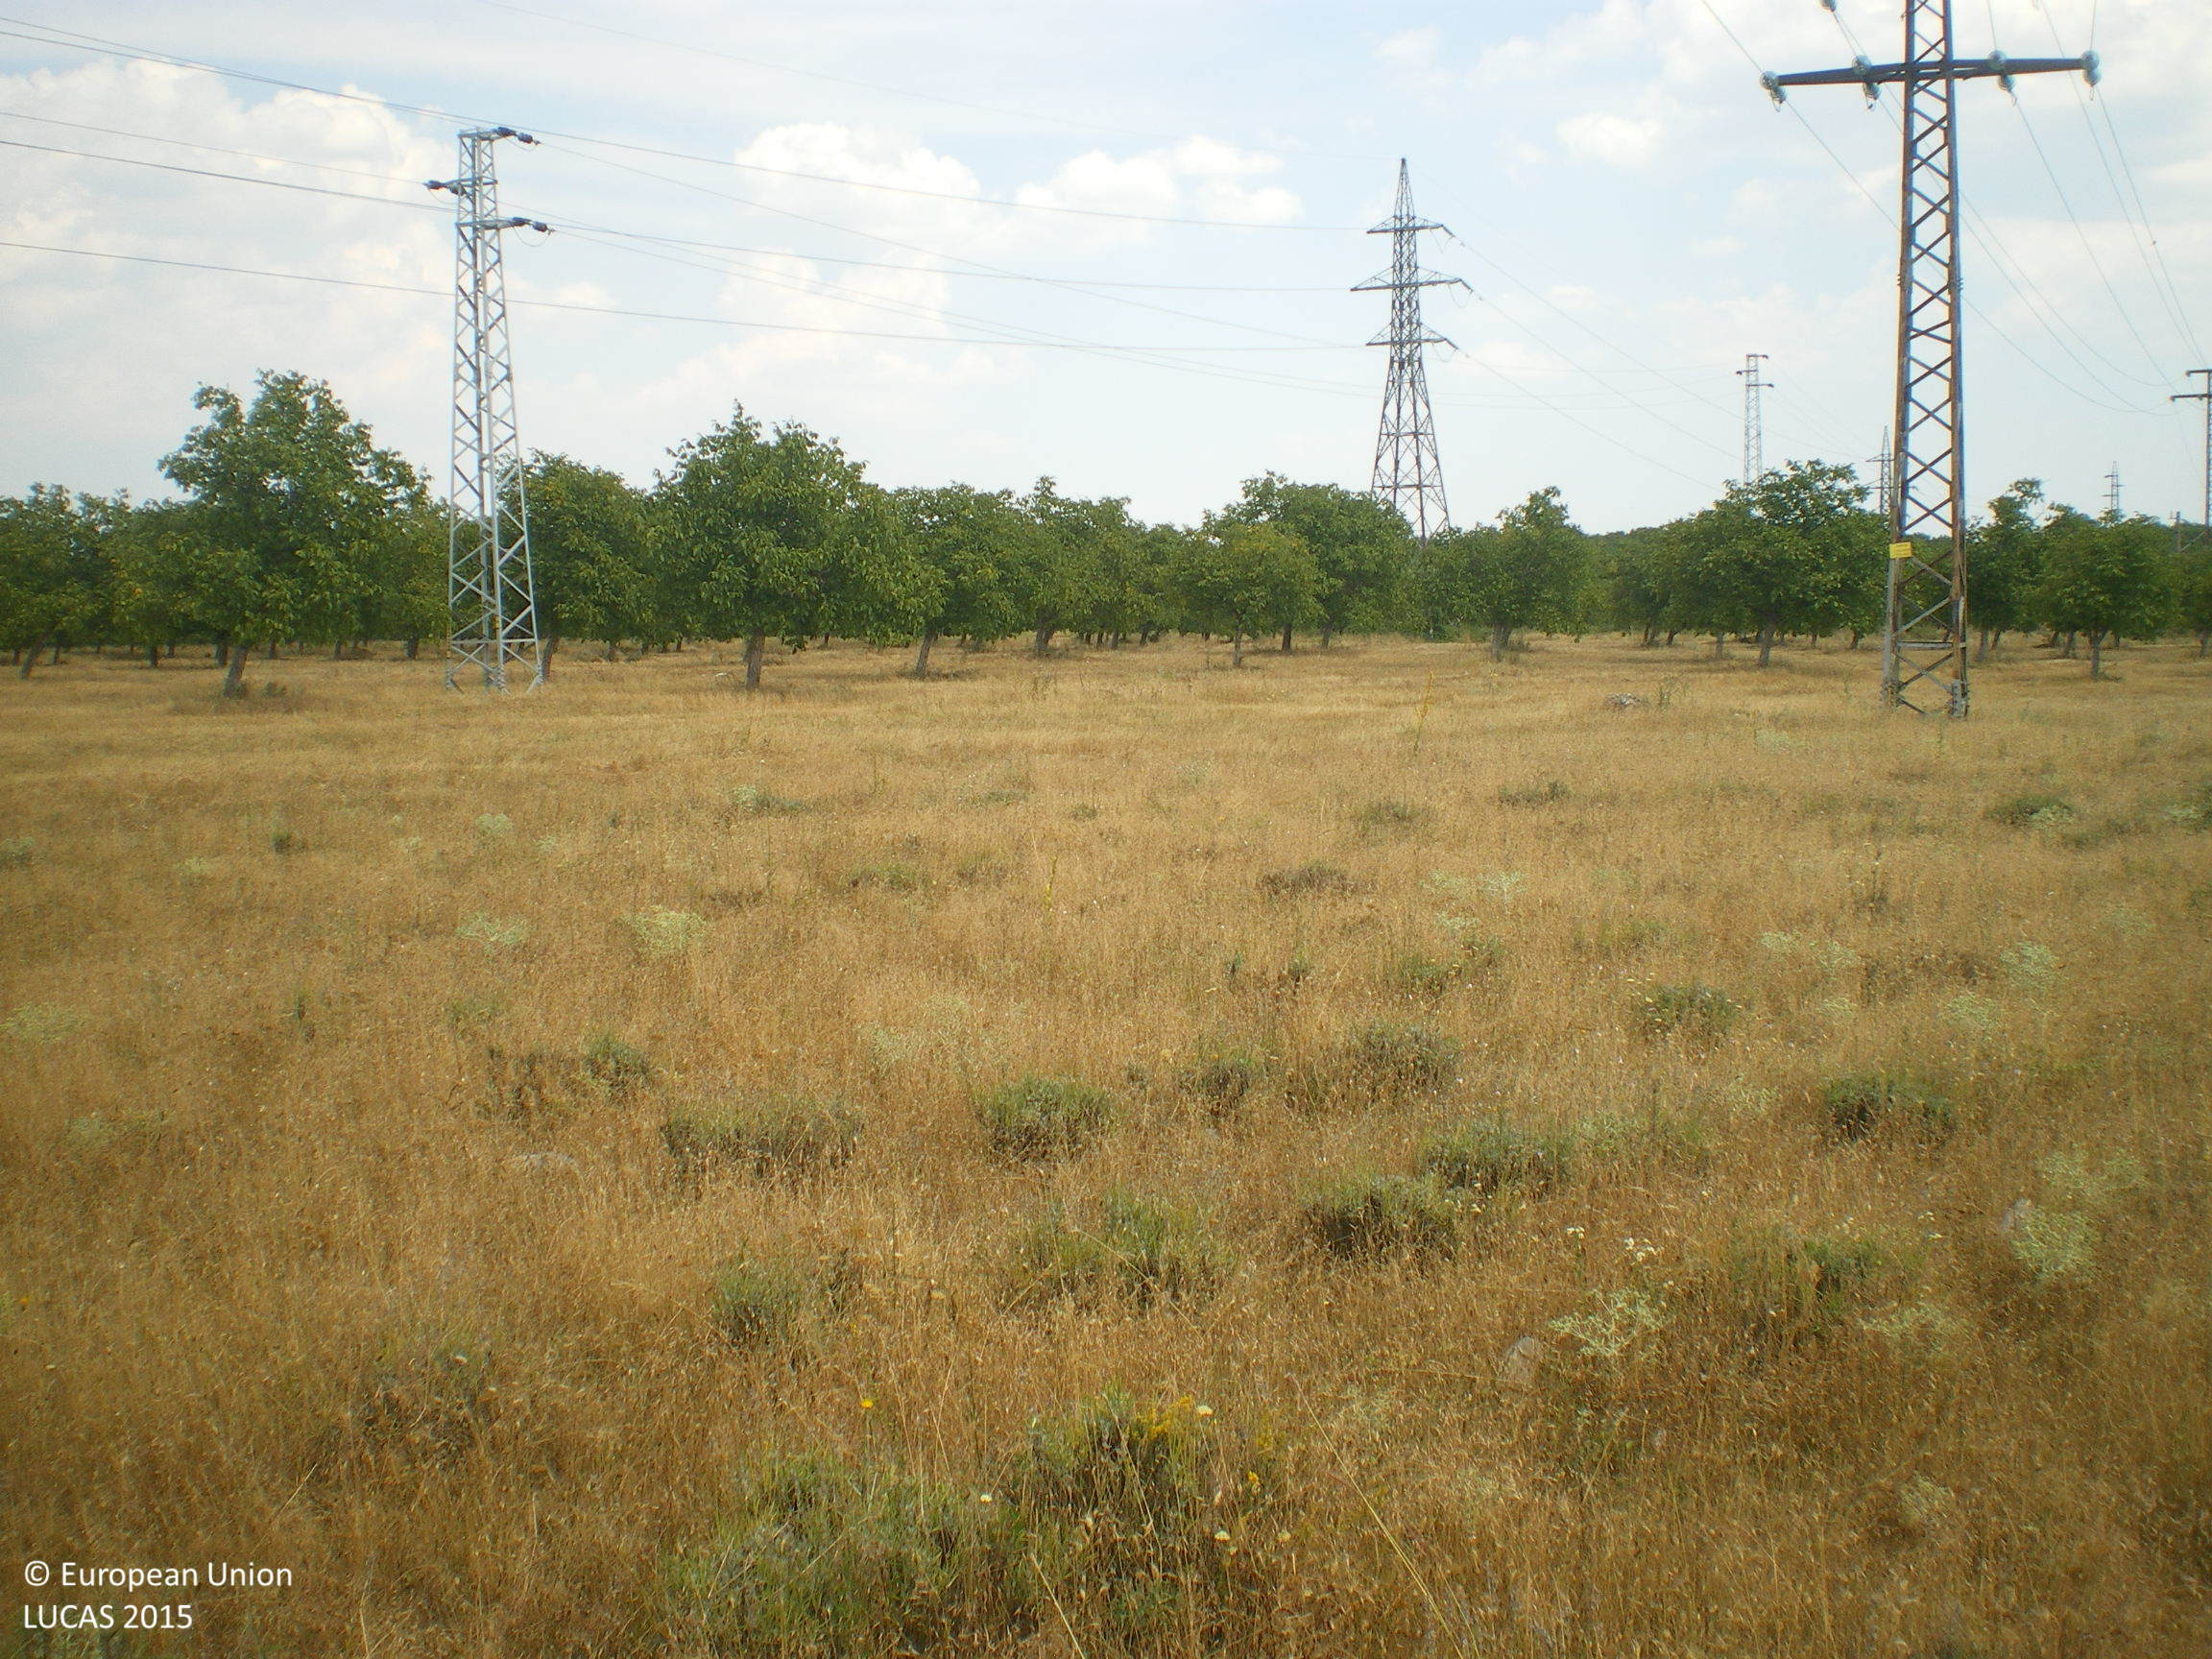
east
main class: Grassland
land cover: Grassland without tree/shrub cover
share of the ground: > 75 %
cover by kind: herbaceous plants 100 %
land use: Semi-natural and natural areas not in use
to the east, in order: Grassland without tree/shrub cover; Electric lines; Grass margins; Tracks; Nuts trees; Electric lines; Nuts trees; Electric lines; Nuts trees; Tracks; Nuts trees
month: July
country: BG
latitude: 42.6504
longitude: 25.2283
